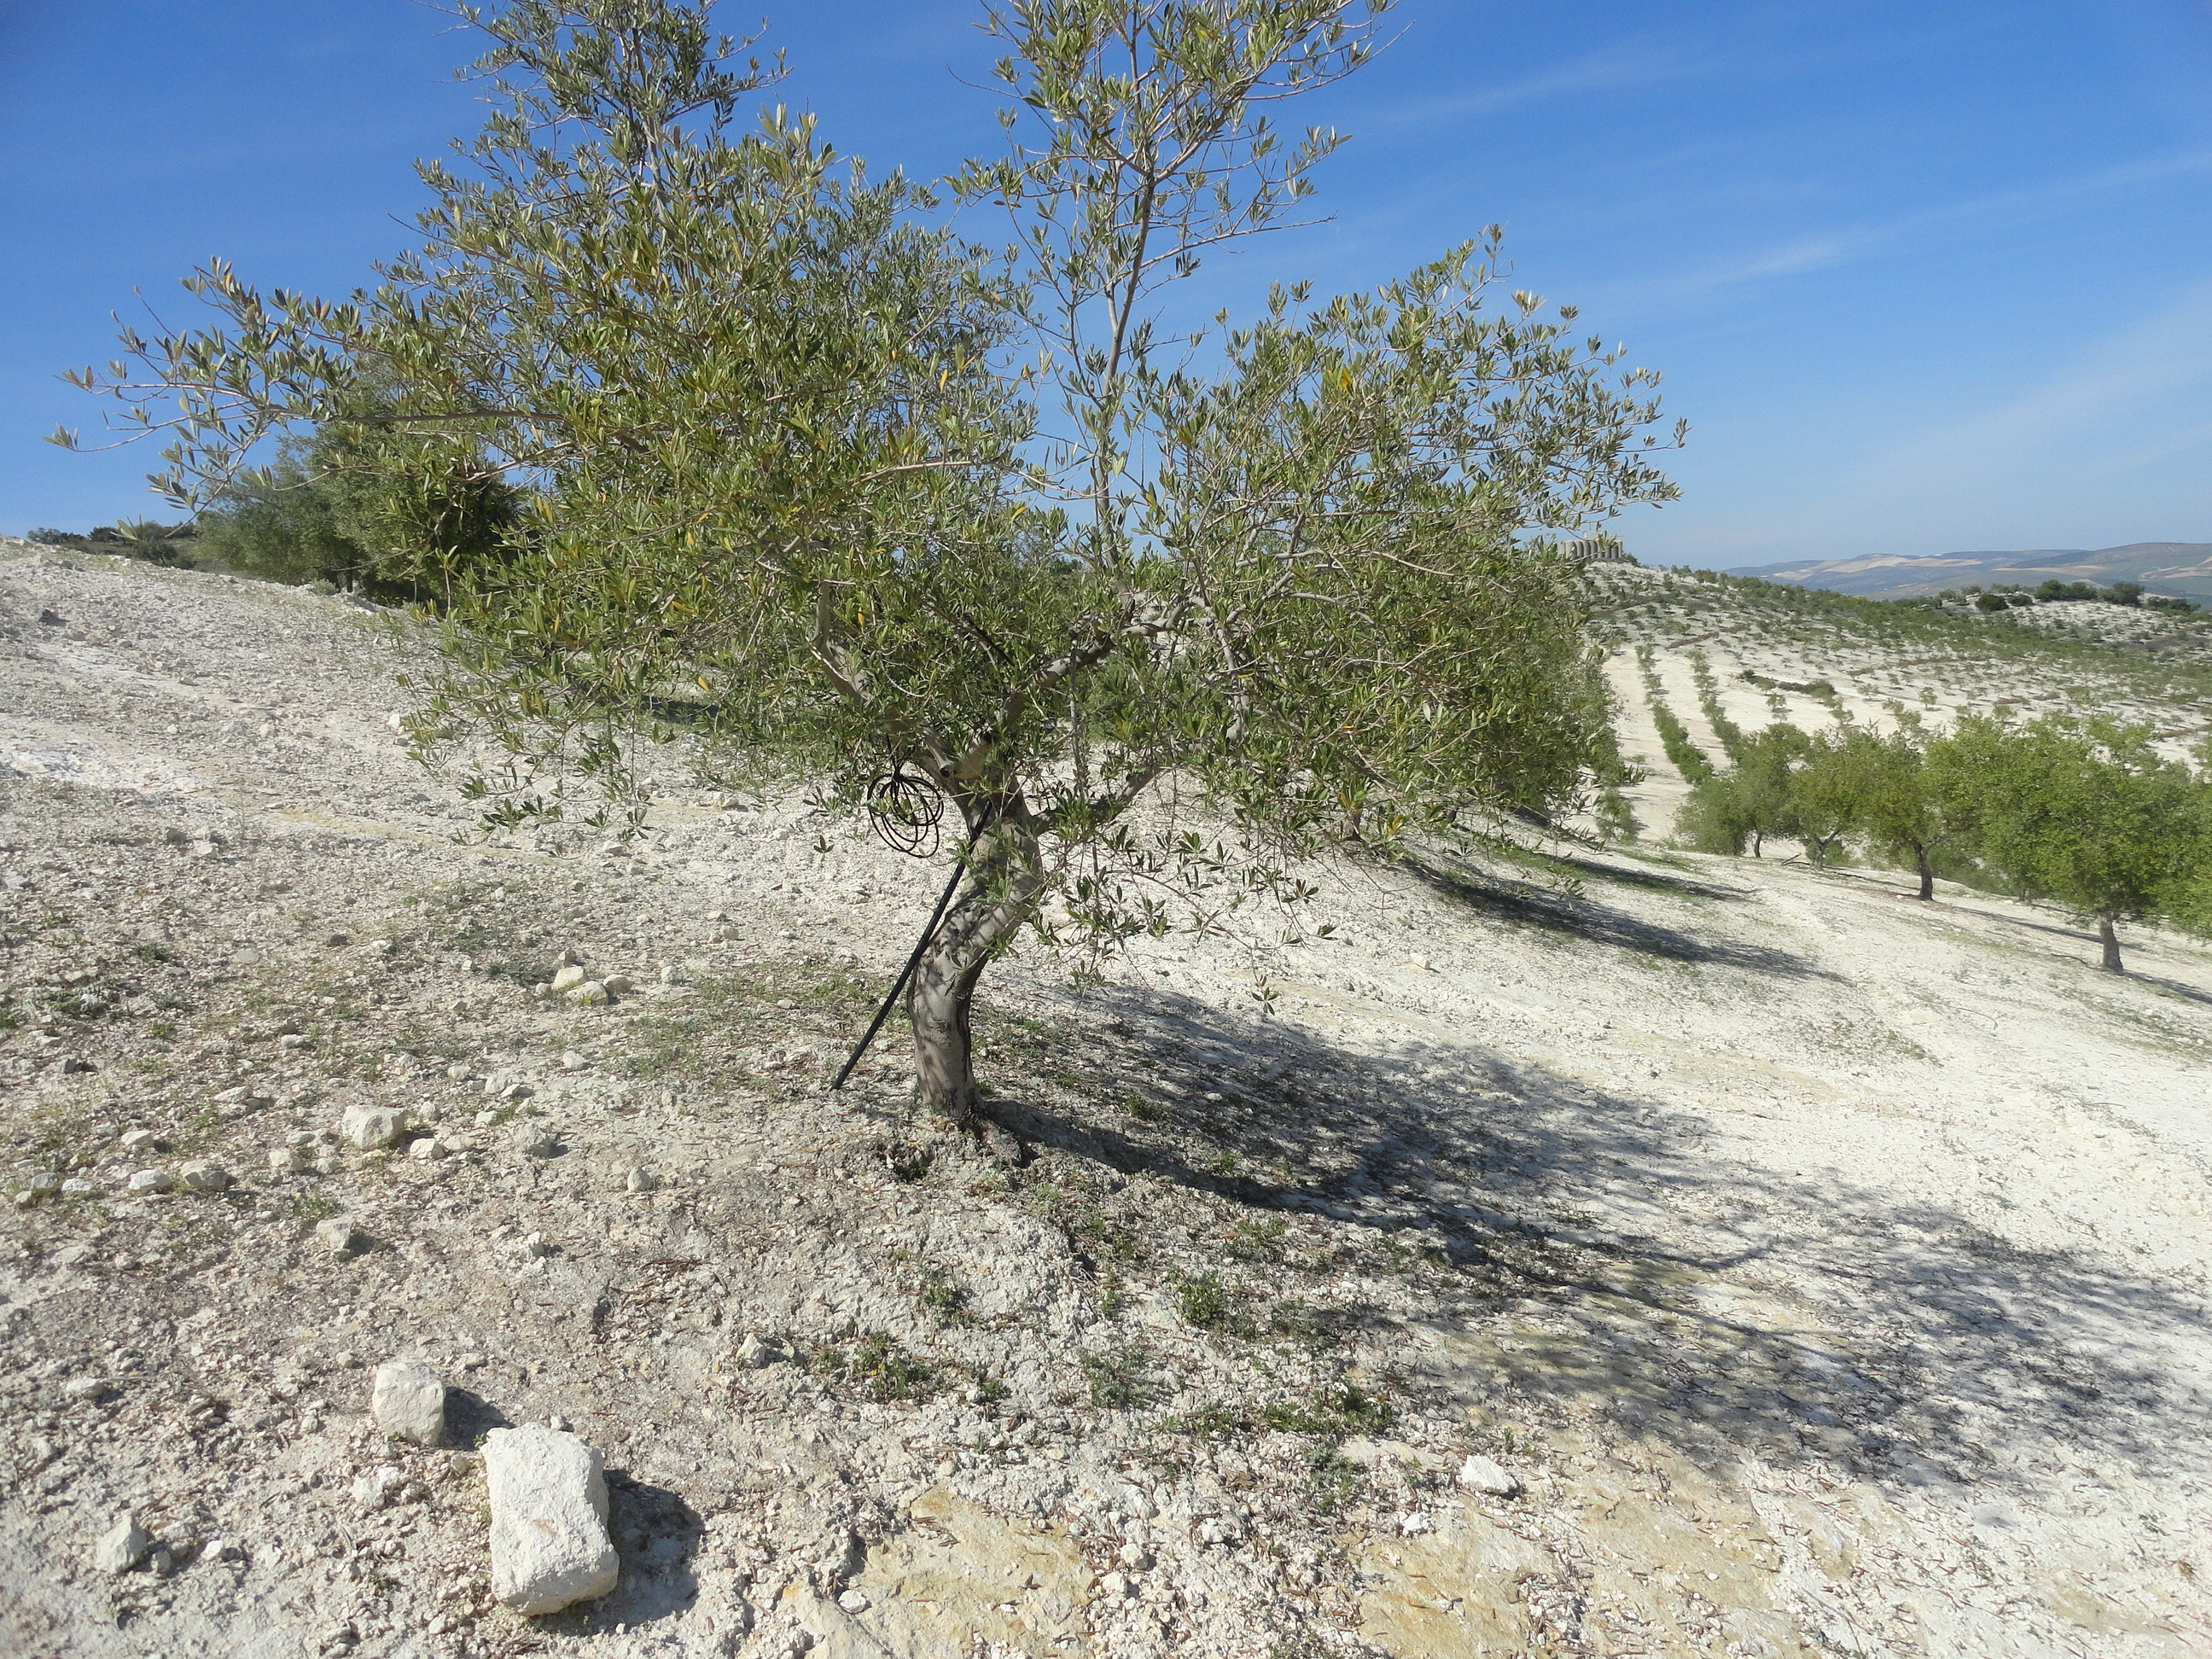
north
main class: Cropland
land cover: Olive groves
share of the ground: 25 - 50 %
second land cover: Other bare soil
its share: > 75 %
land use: Agriculture (excluding fallow land and kitchen gardens)
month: April
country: ES
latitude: 37.6477
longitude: -4.4570
